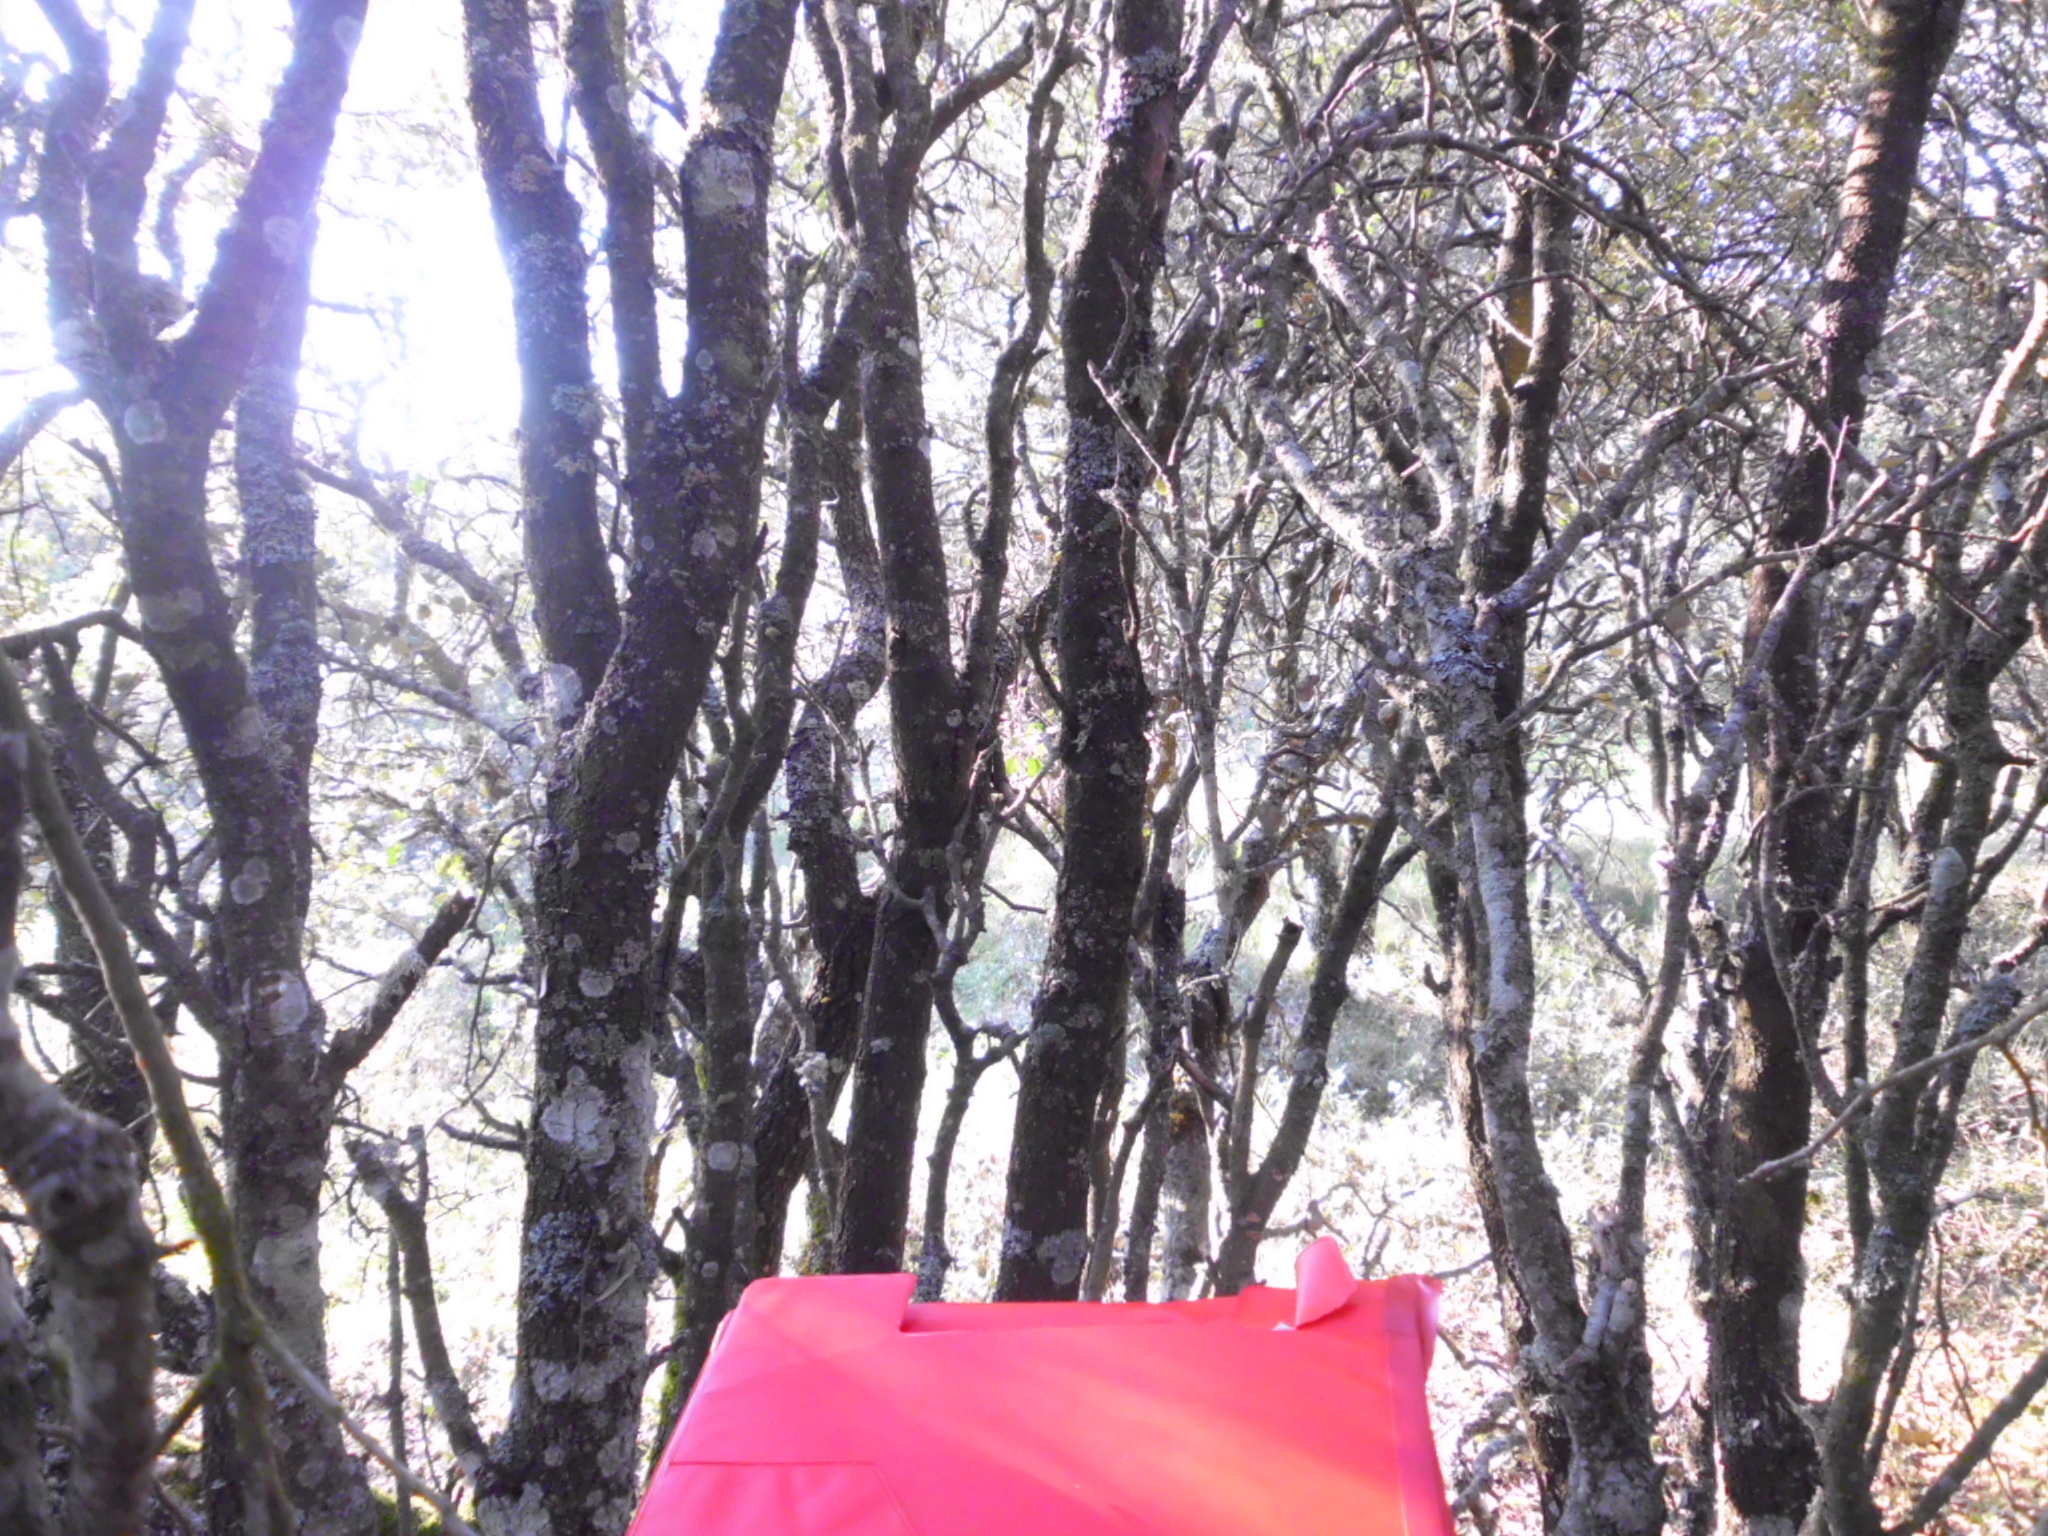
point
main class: Woodland
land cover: Broadleaved woodland
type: acidophilous oak and oak-birch forest
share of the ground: > 75 %
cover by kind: broadleaved forest trees 80 %, herbaceous plants 15 %, shrubs 5 %
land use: Semi-natural and natural areas not in use
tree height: < 5 m
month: June
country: ES
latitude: 42.3758
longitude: -3.9706
